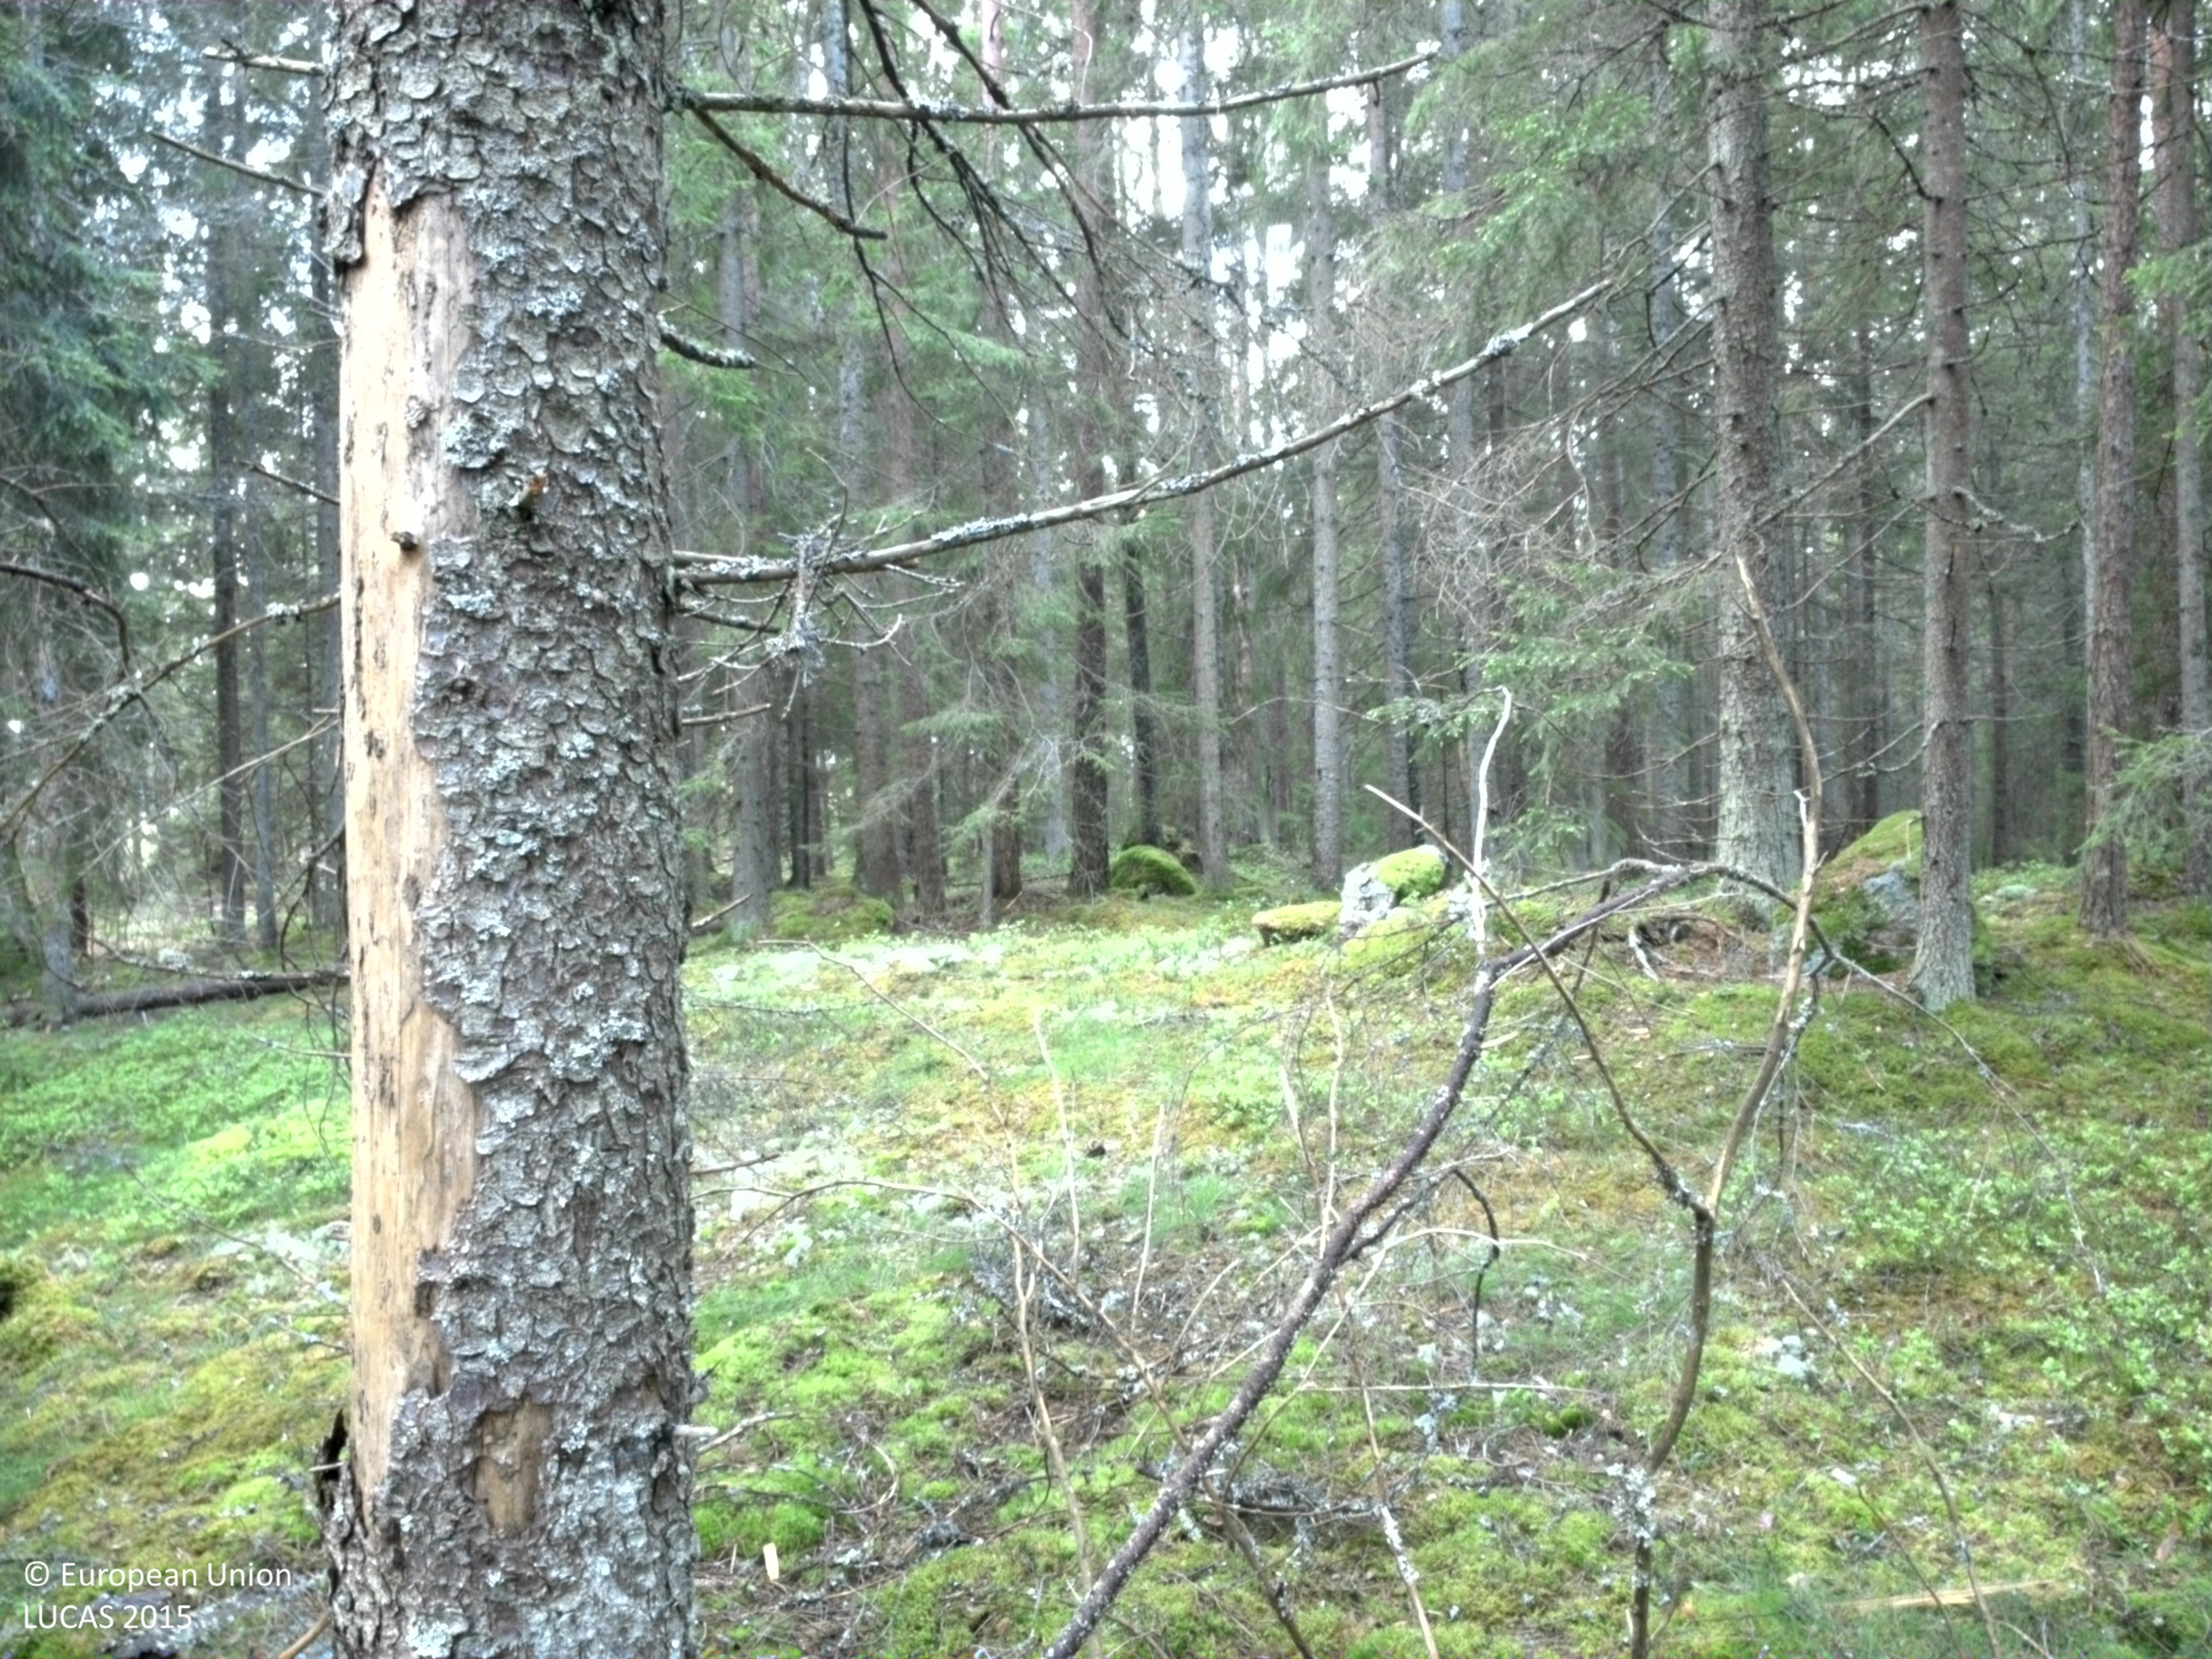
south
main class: Woodland
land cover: Spruce dominated coniferous woodland
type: boreal forest
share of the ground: 50 - 75 %
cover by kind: coniferous forest trees 55 %, lichens and mosses 35 %, shrubs 5 %, herbaceous plants 5 %
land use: Forestry
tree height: > 5 m
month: May
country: SE
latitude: 56.8434
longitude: 15.0961
